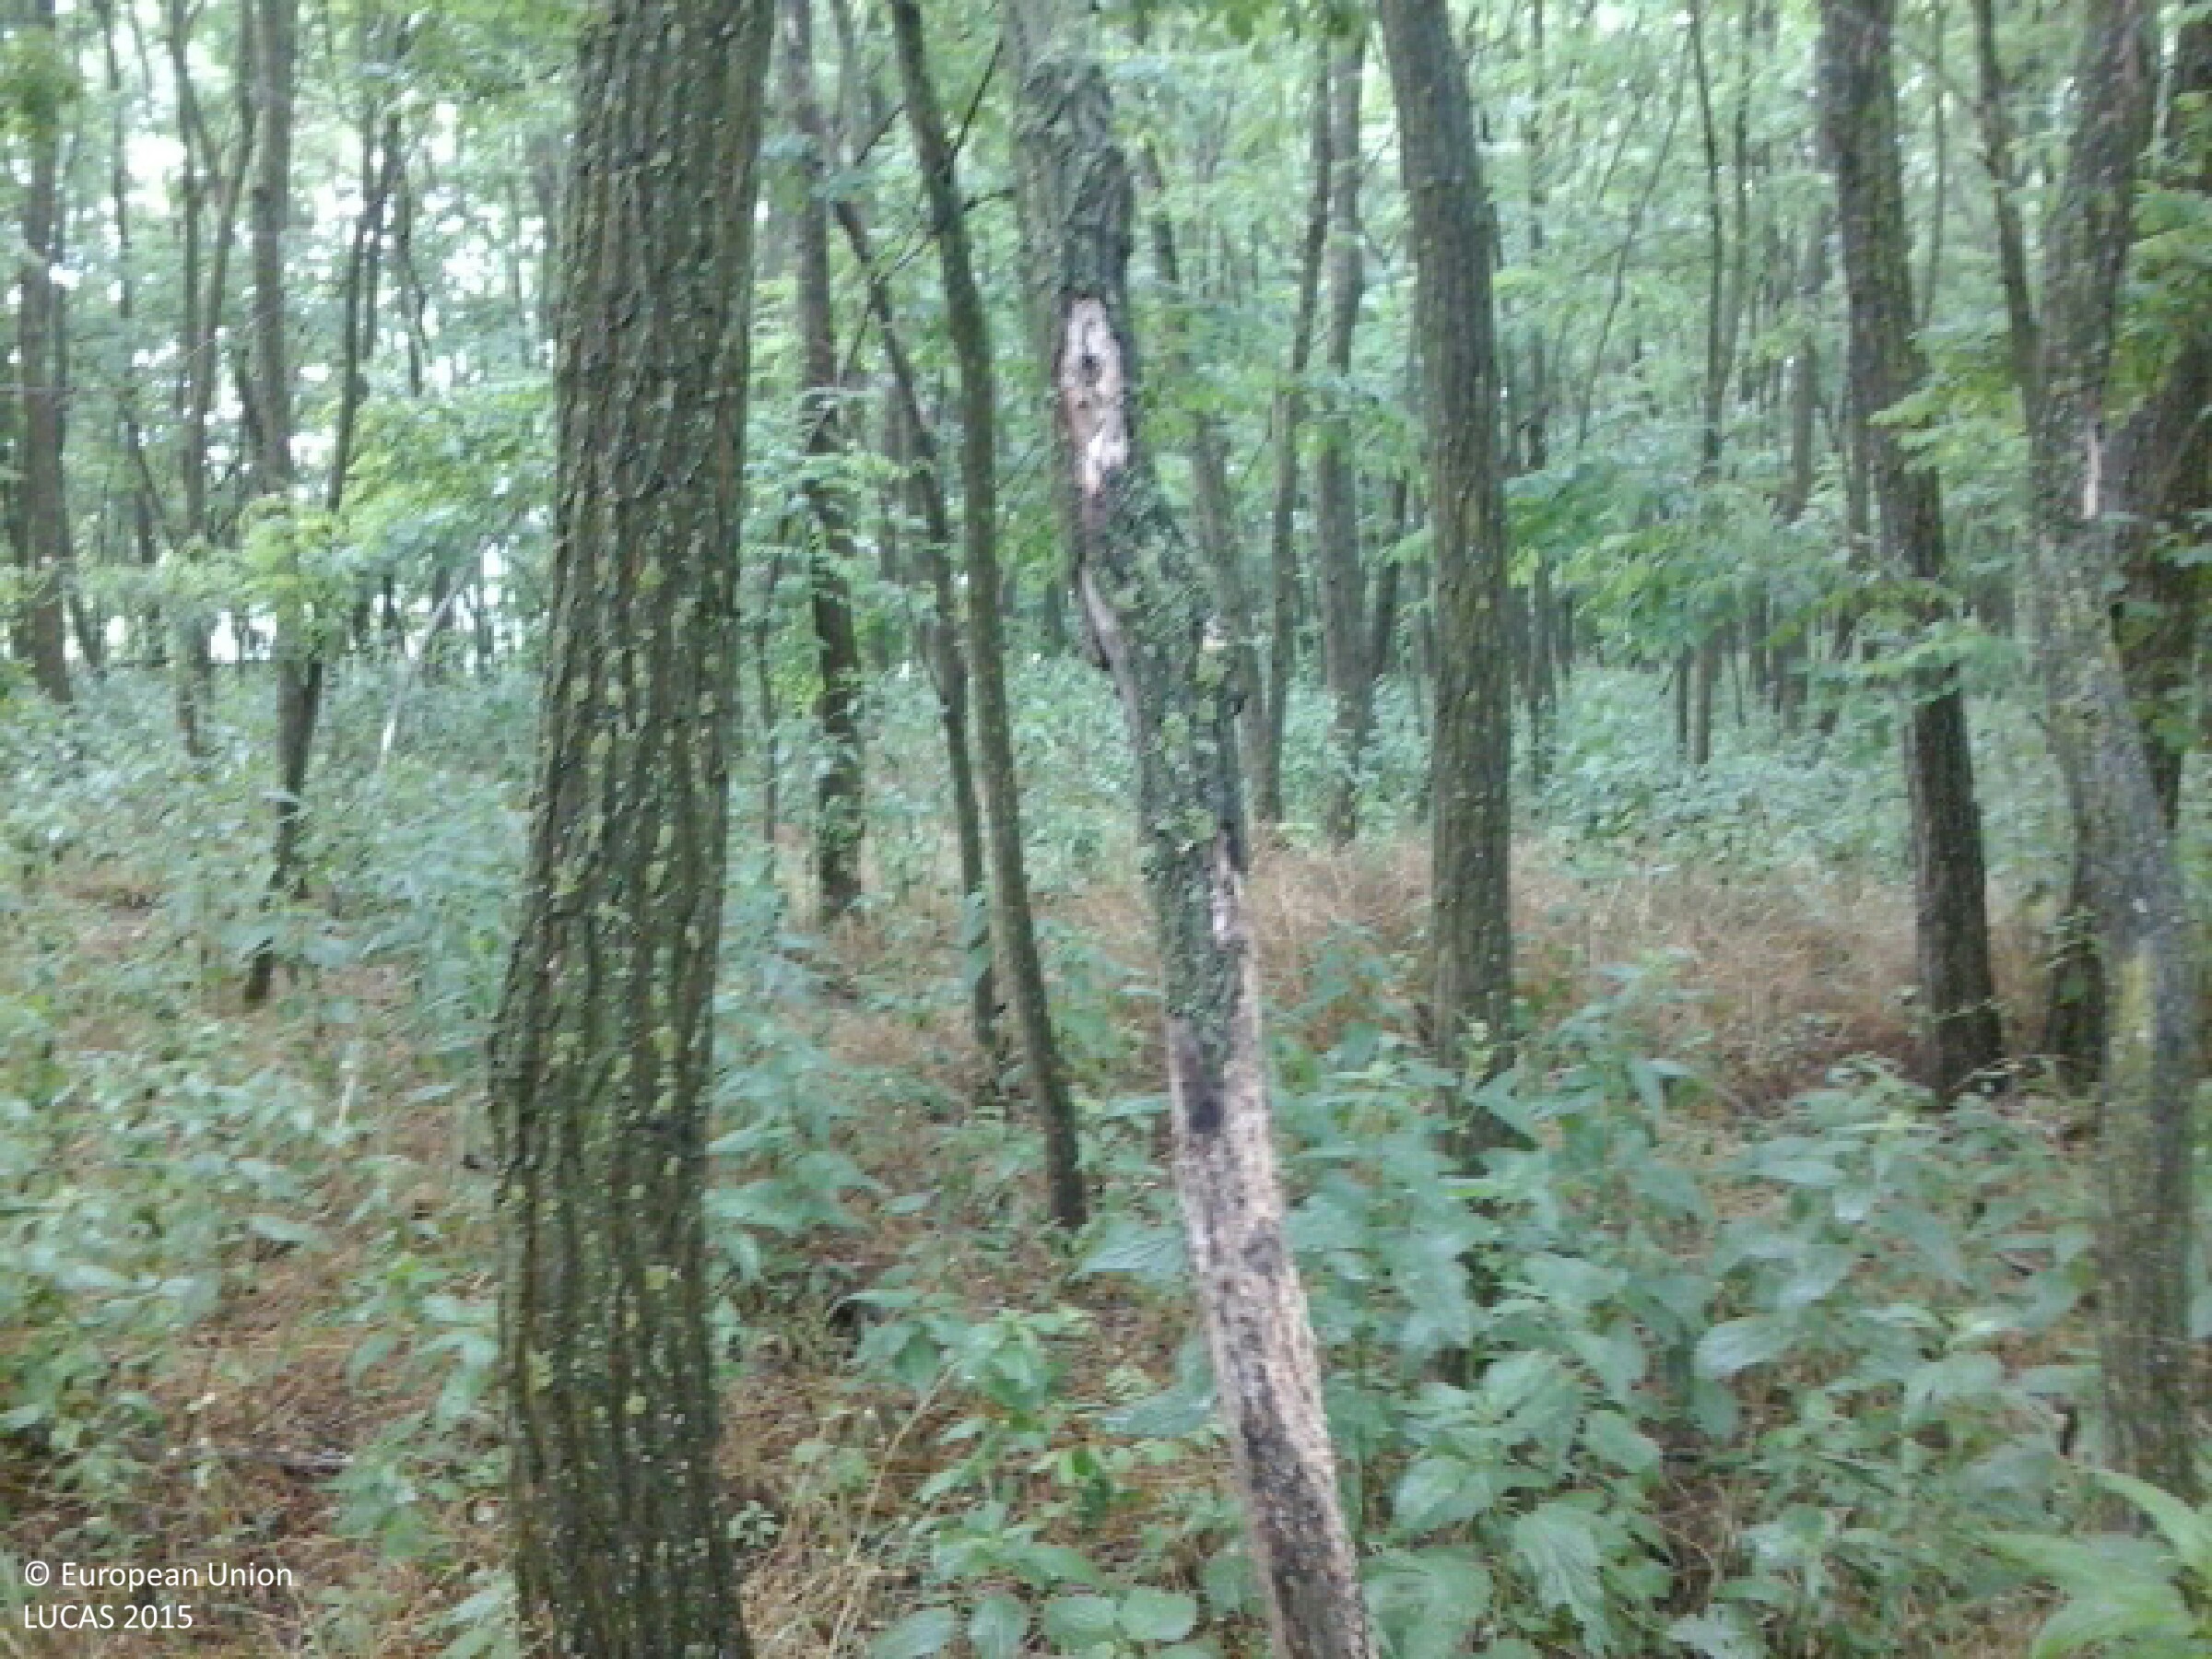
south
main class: Woodland
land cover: Broadleaved woodland
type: mesophytic deciduous forest
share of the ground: > 75 %
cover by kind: broadleaved forest trees 95 %, herbaceous plants 5 %
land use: Forestry
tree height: > 5 m
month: June
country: HU
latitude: 48.0202
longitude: 21.9985
